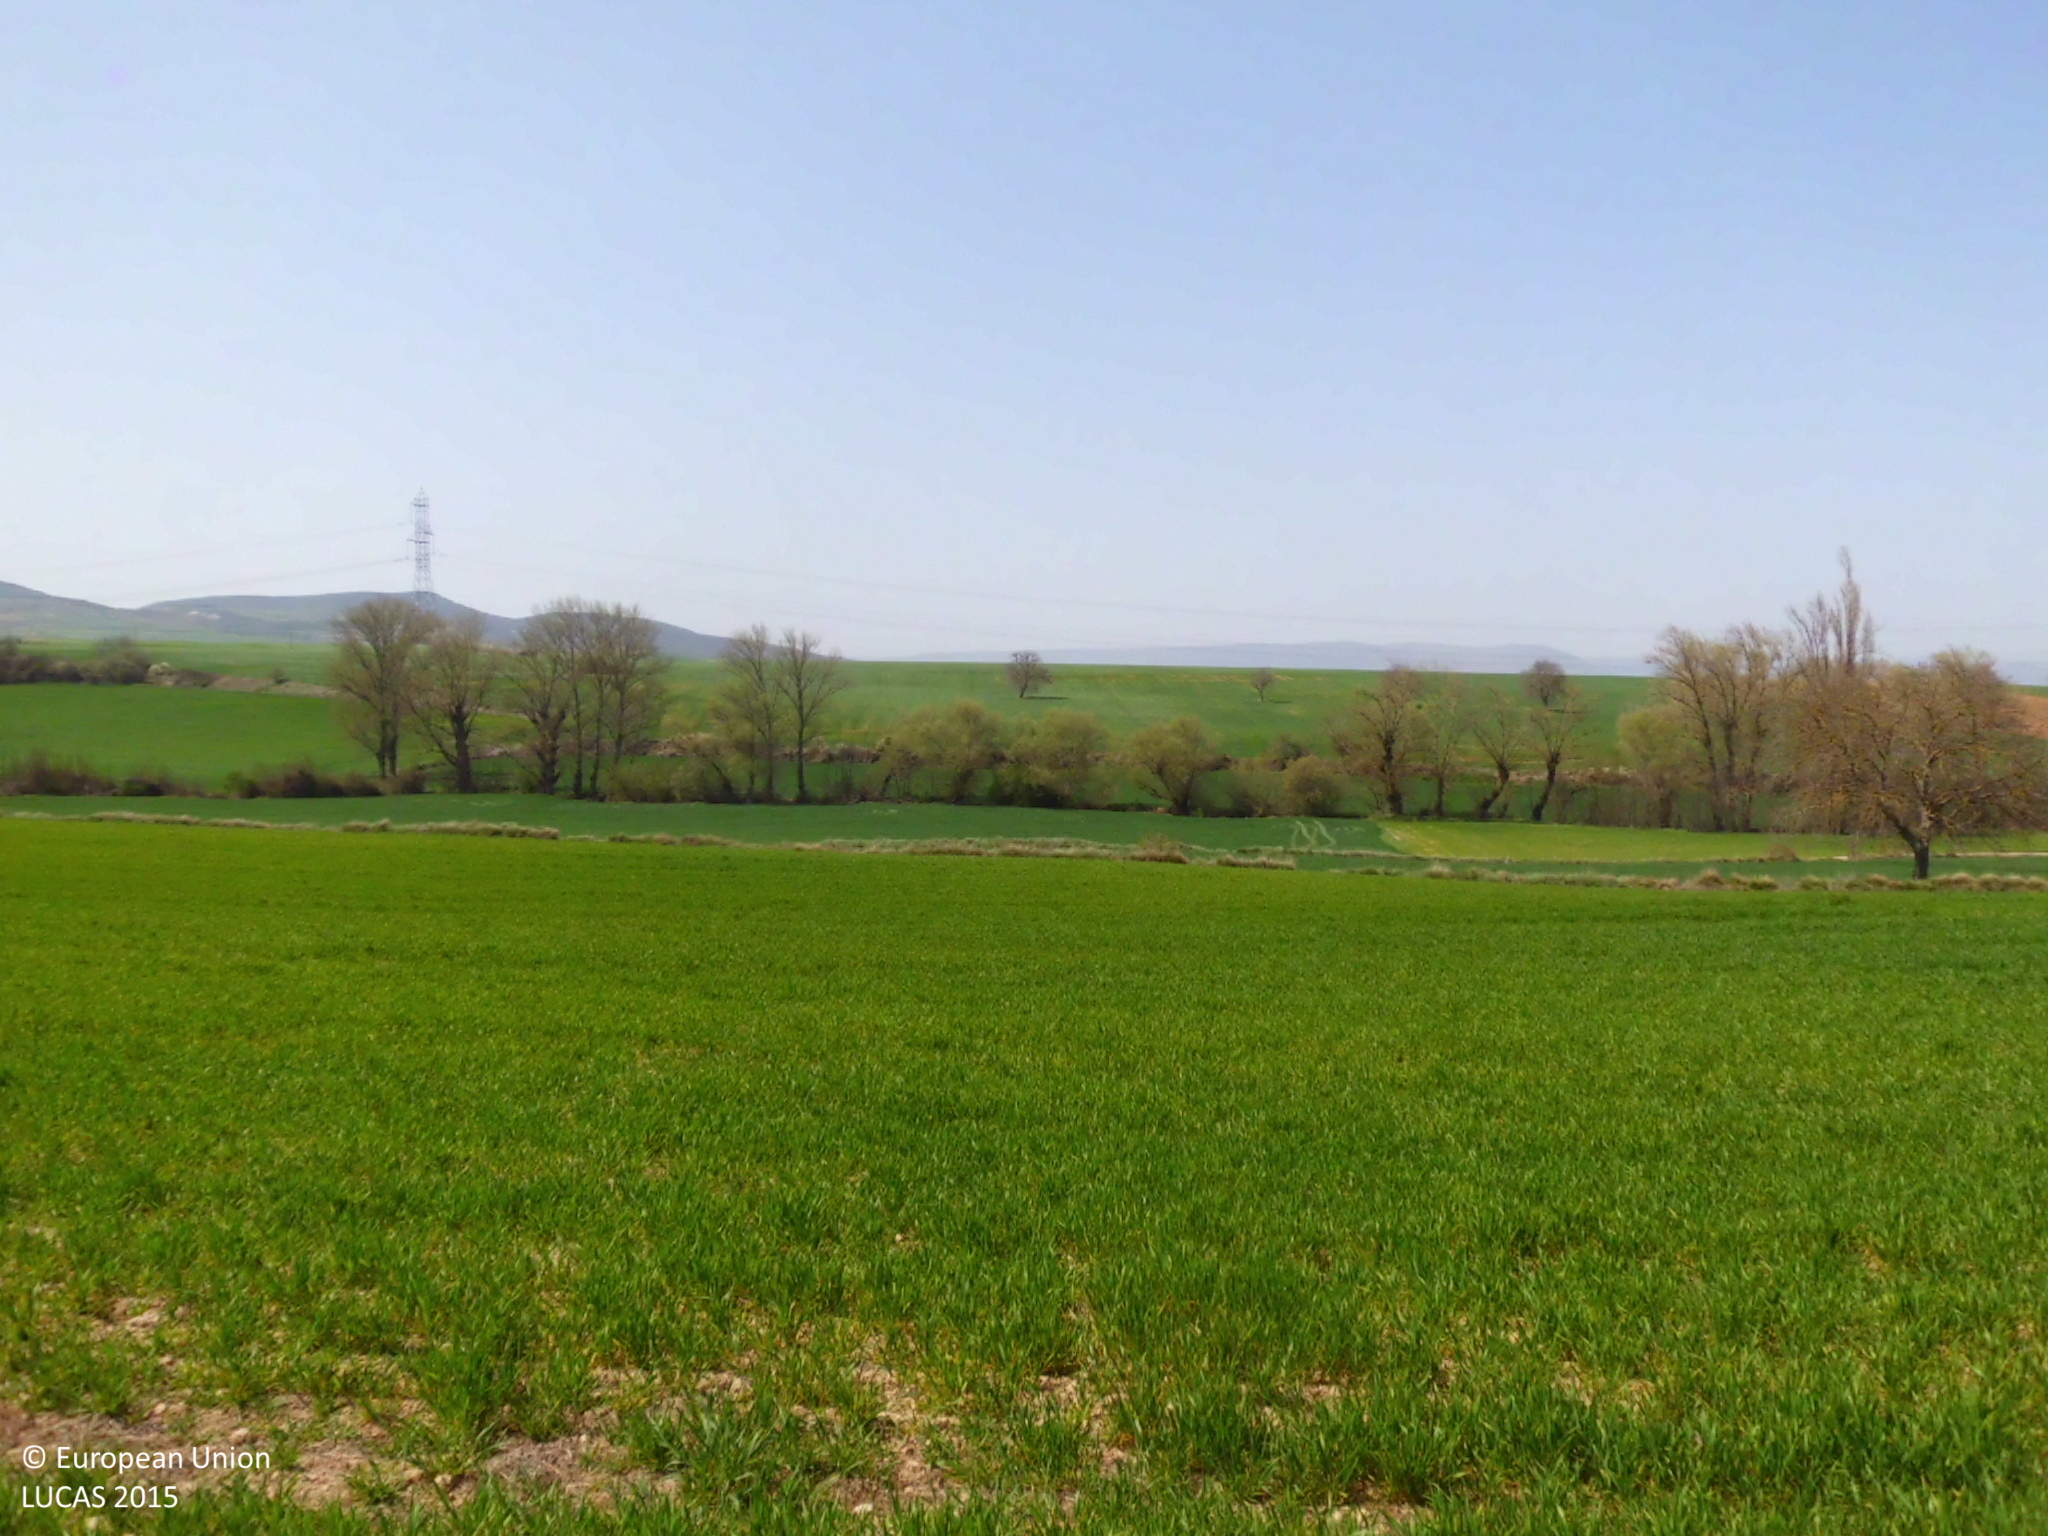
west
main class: Cropland
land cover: Barley
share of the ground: 50 - 75 %
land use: Agriculture (excluding fallow land and kitchen gardens)
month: April
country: ES
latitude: 42.5735
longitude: -3.3245
